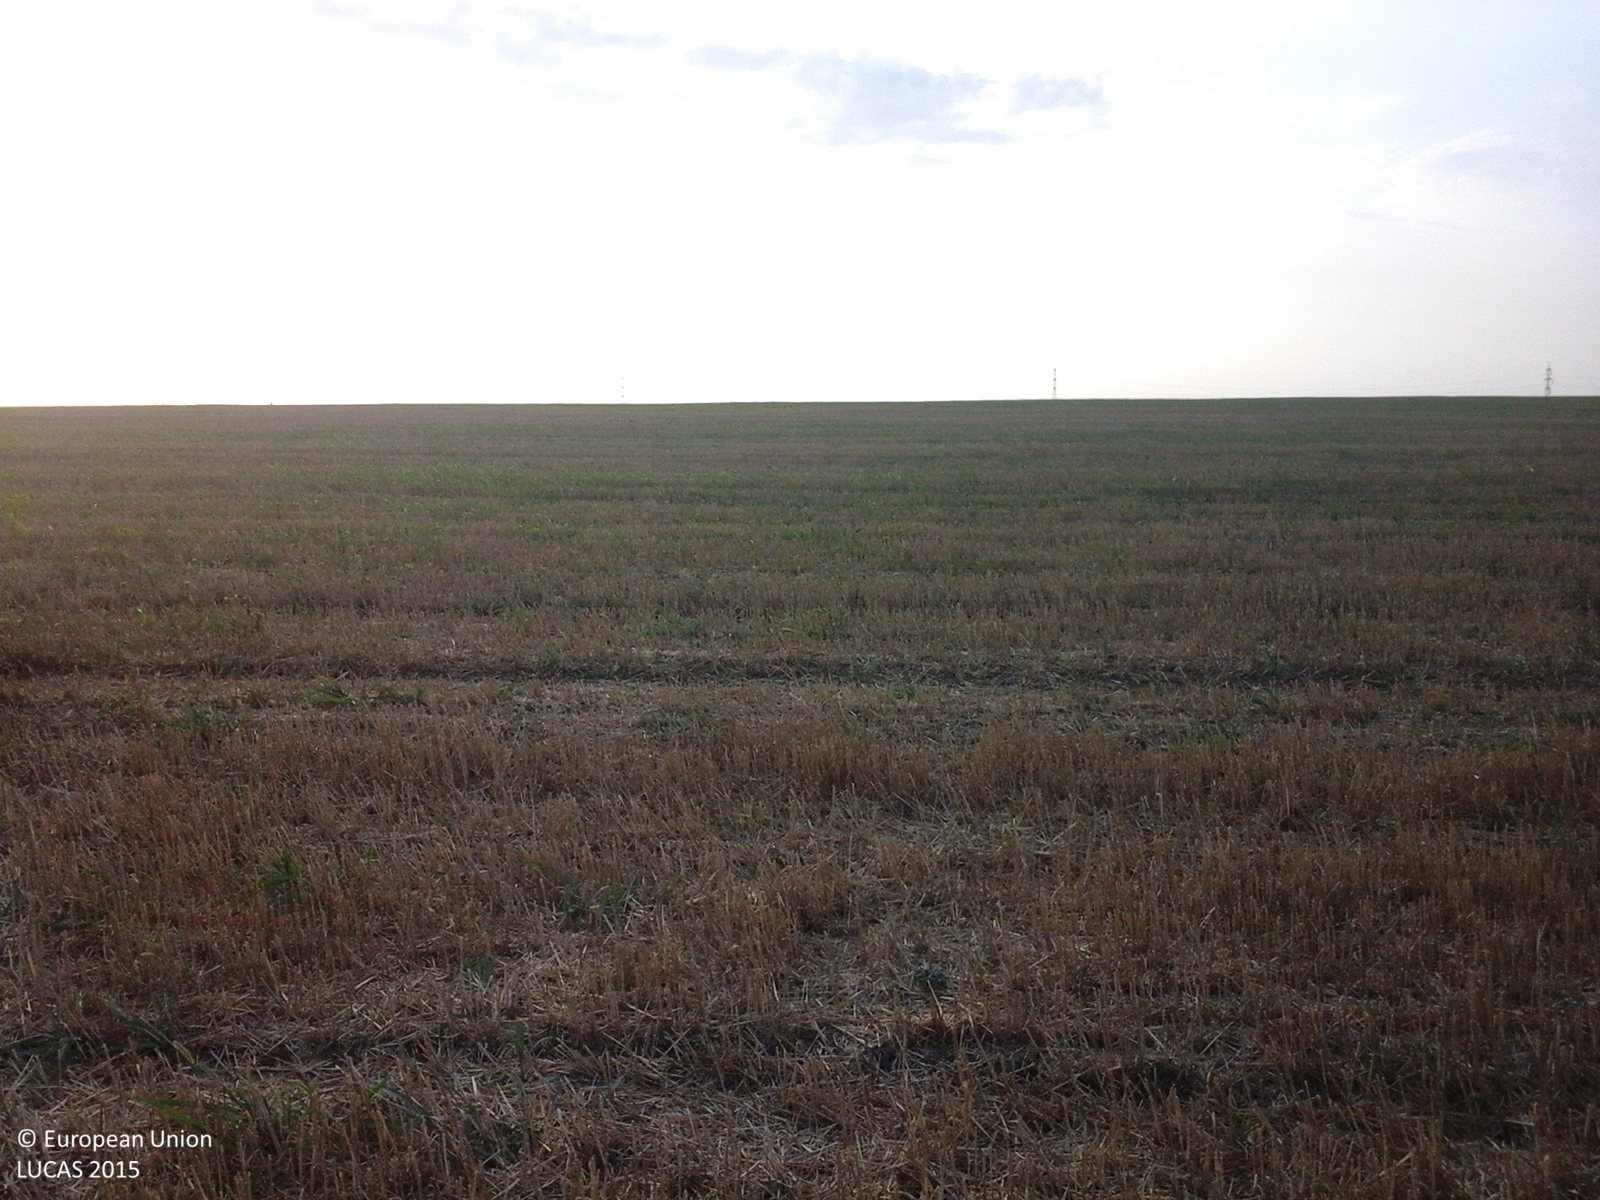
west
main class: Cropland
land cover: Common wheat
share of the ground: > 75 %
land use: Agriculture (excluding fallow land and kitchen gardens)
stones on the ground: < 10 %
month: August
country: RO
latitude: 44.0059
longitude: 28.1539
